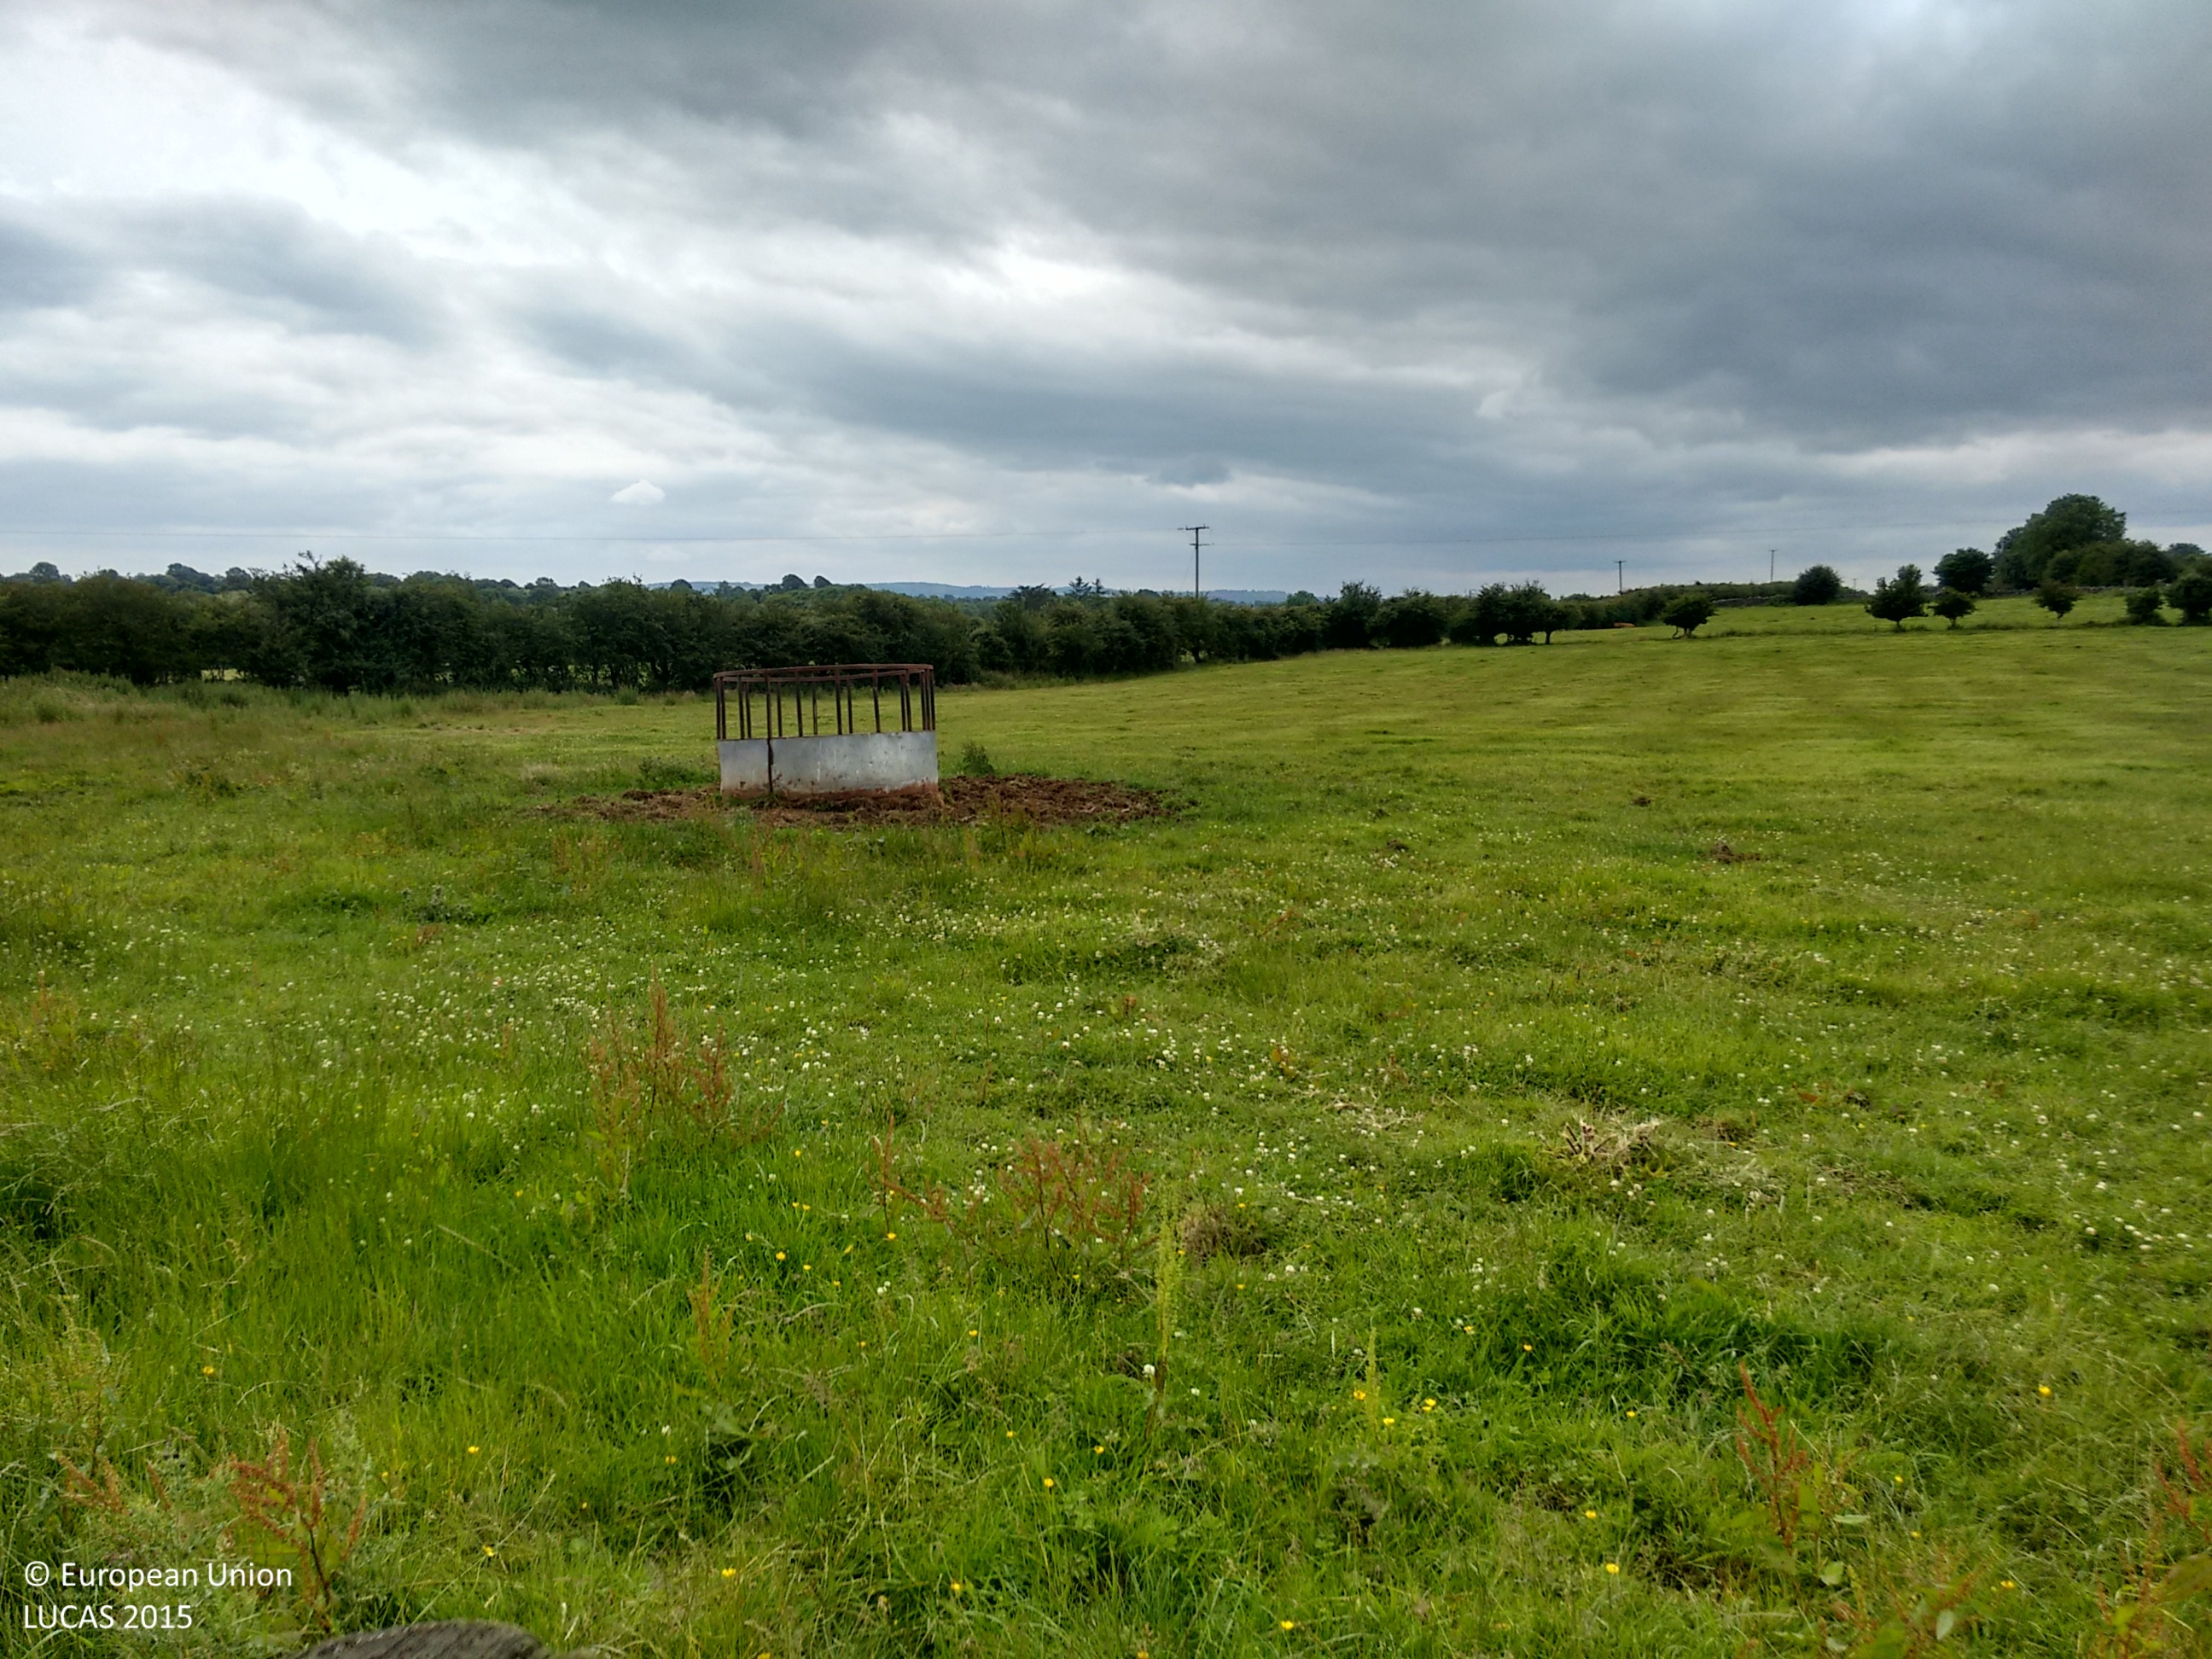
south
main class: Grassland
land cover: Grassland without tree/shrub cover
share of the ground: > 75 %
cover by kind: herbaceous plants 100 %
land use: Agriculture (excluding fallow land and kitchen gardens)
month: July
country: IE
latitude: 53.6705
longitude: -8.1782
